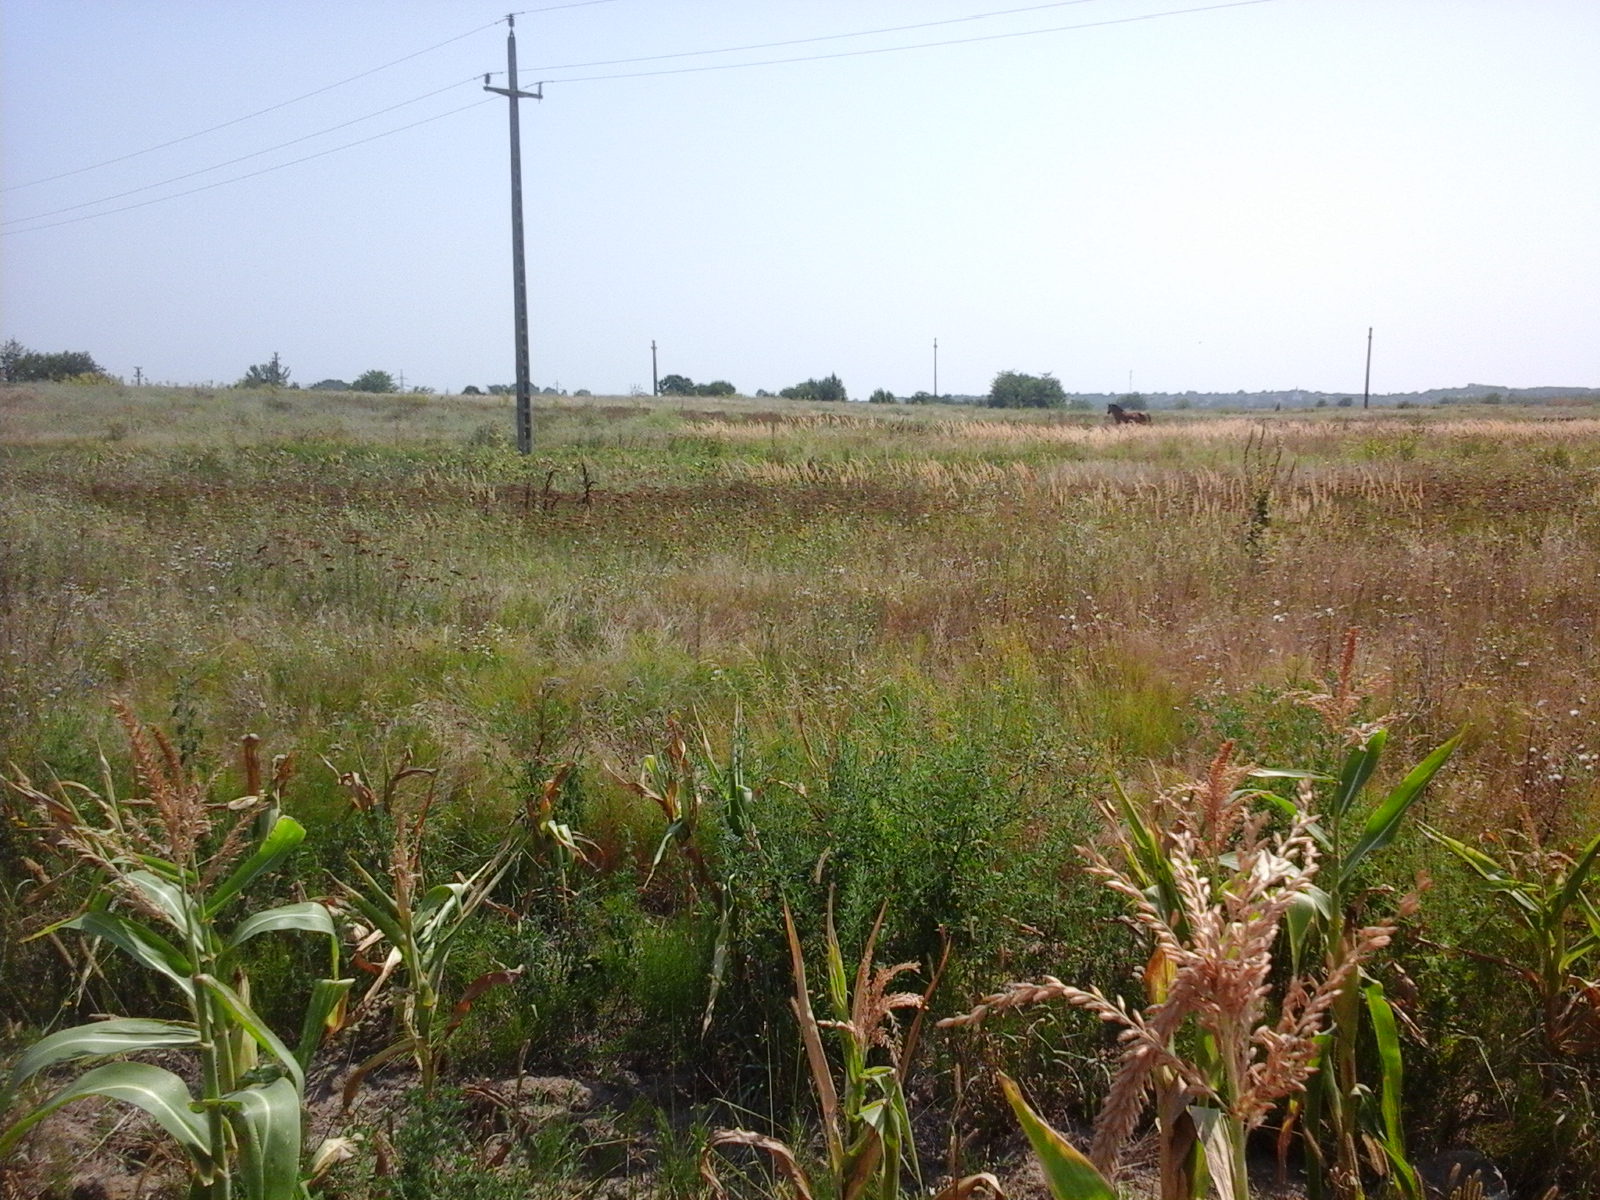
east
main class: Cropland
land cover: Maize
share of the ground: > 75 %
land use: Agriculture (excluding fallow land and kitchen gardens)
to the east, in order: Maize; Spontaneously vegetated surfaces; Maize; Spontaneously vegetated surfaces; Electric lines; Spontaneously vegetated surfaces; Common wheat; Spontaneously vegetated surfaces
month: August
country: RO
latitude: 44.4075
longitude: 22.6852
